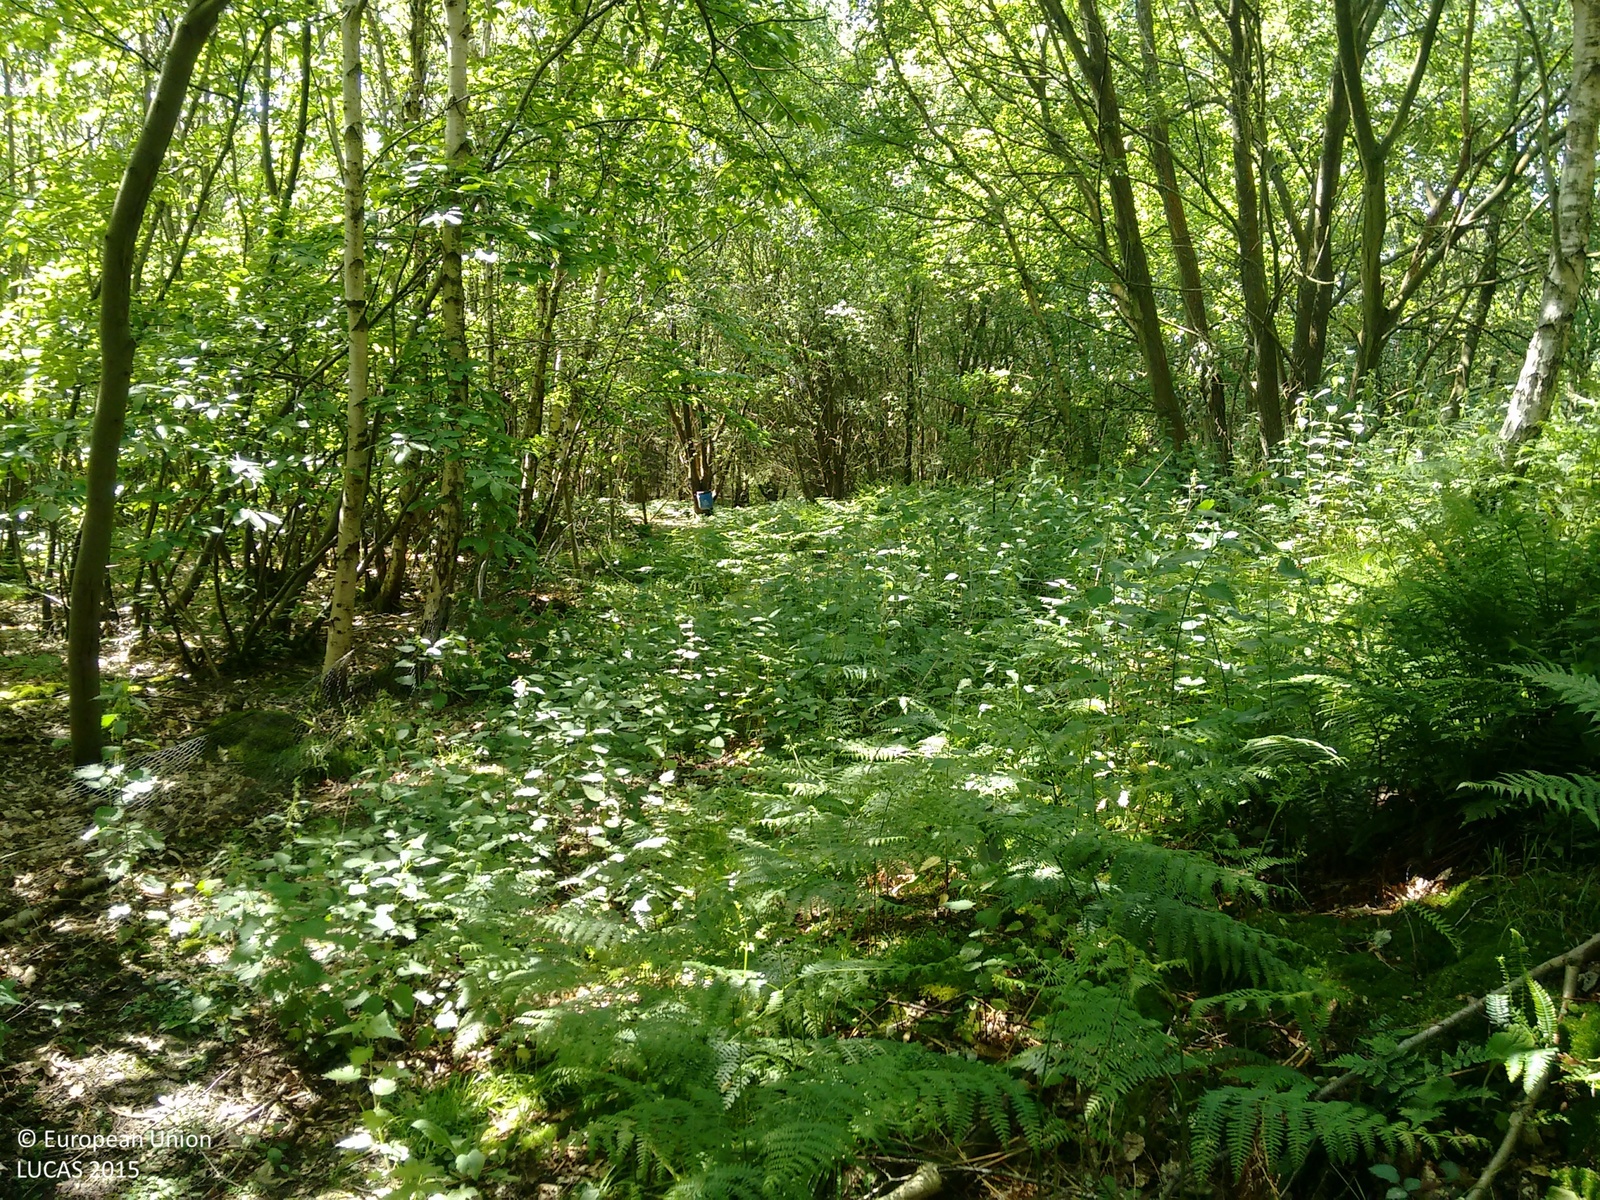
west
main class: Woodland
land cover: Broadleaved woodland
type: mesophytic deciduous forest
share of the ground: > 75 %
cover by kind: broadleaved forest trees 75 %, coniferous forest trees 15 %, shrubs 5 %, herbaceous plants 5 %
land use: Forestry
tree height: > 5 m
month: June
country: GB
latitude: 51.0445
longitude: 0.6021
